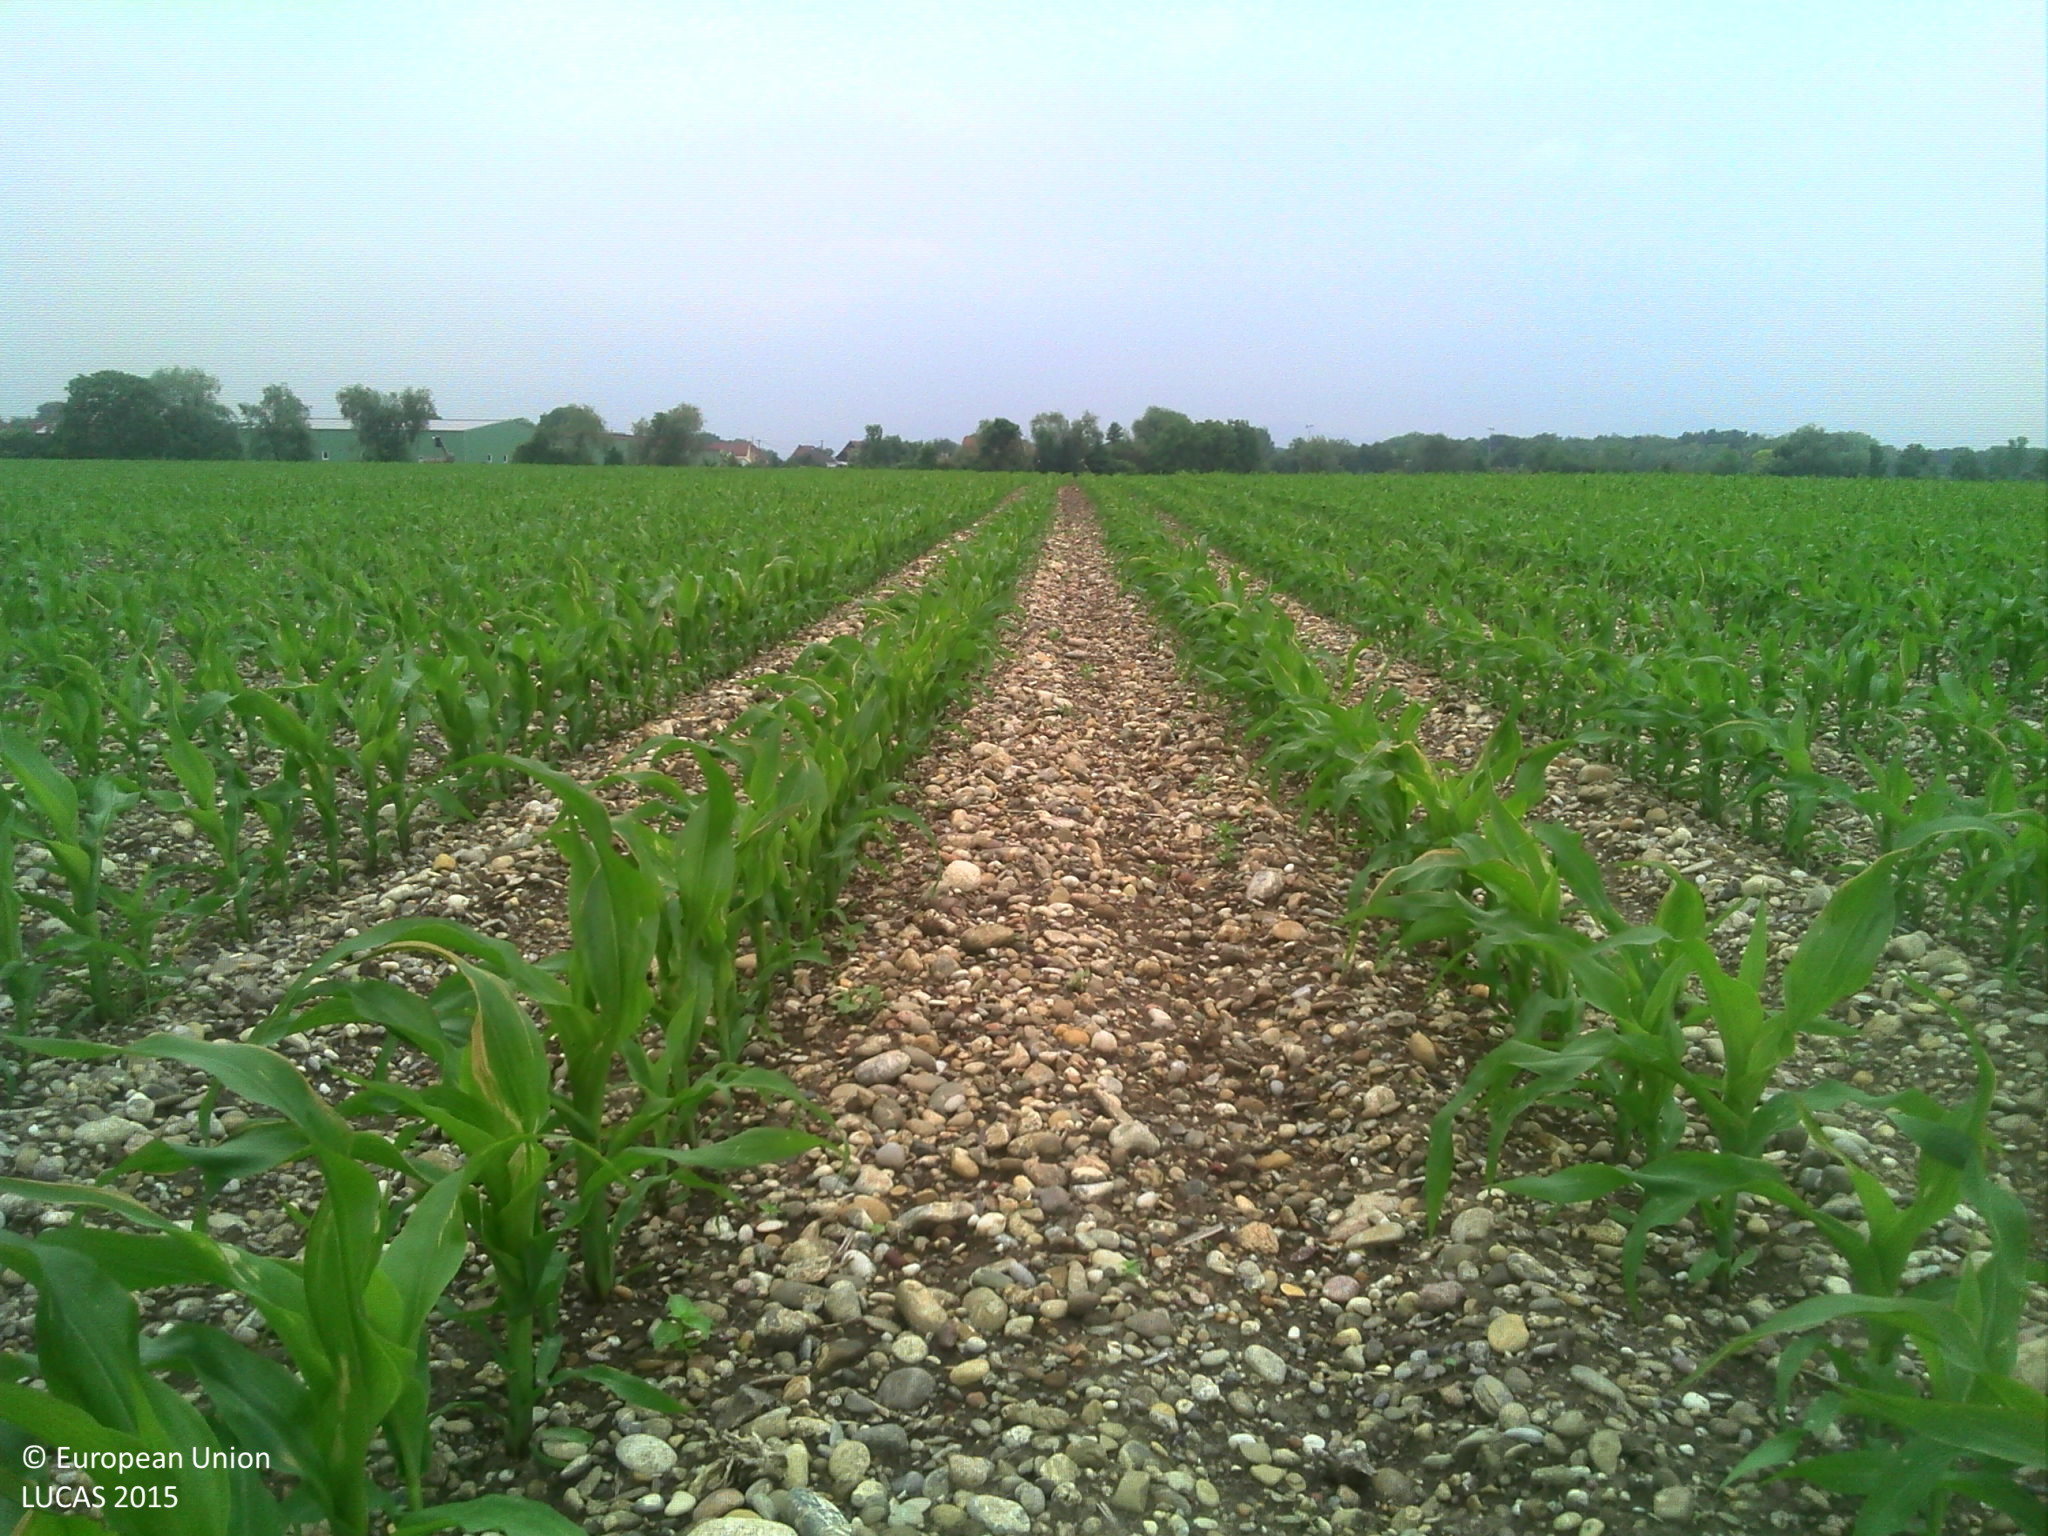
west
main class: Cropland
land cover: Maize
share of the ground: < 10 %
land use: Agriculture (excluding fallow land and kitchen gardens)
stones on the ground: > 50 %
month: May
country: FR
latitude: 48.2878
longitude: 7.6155
